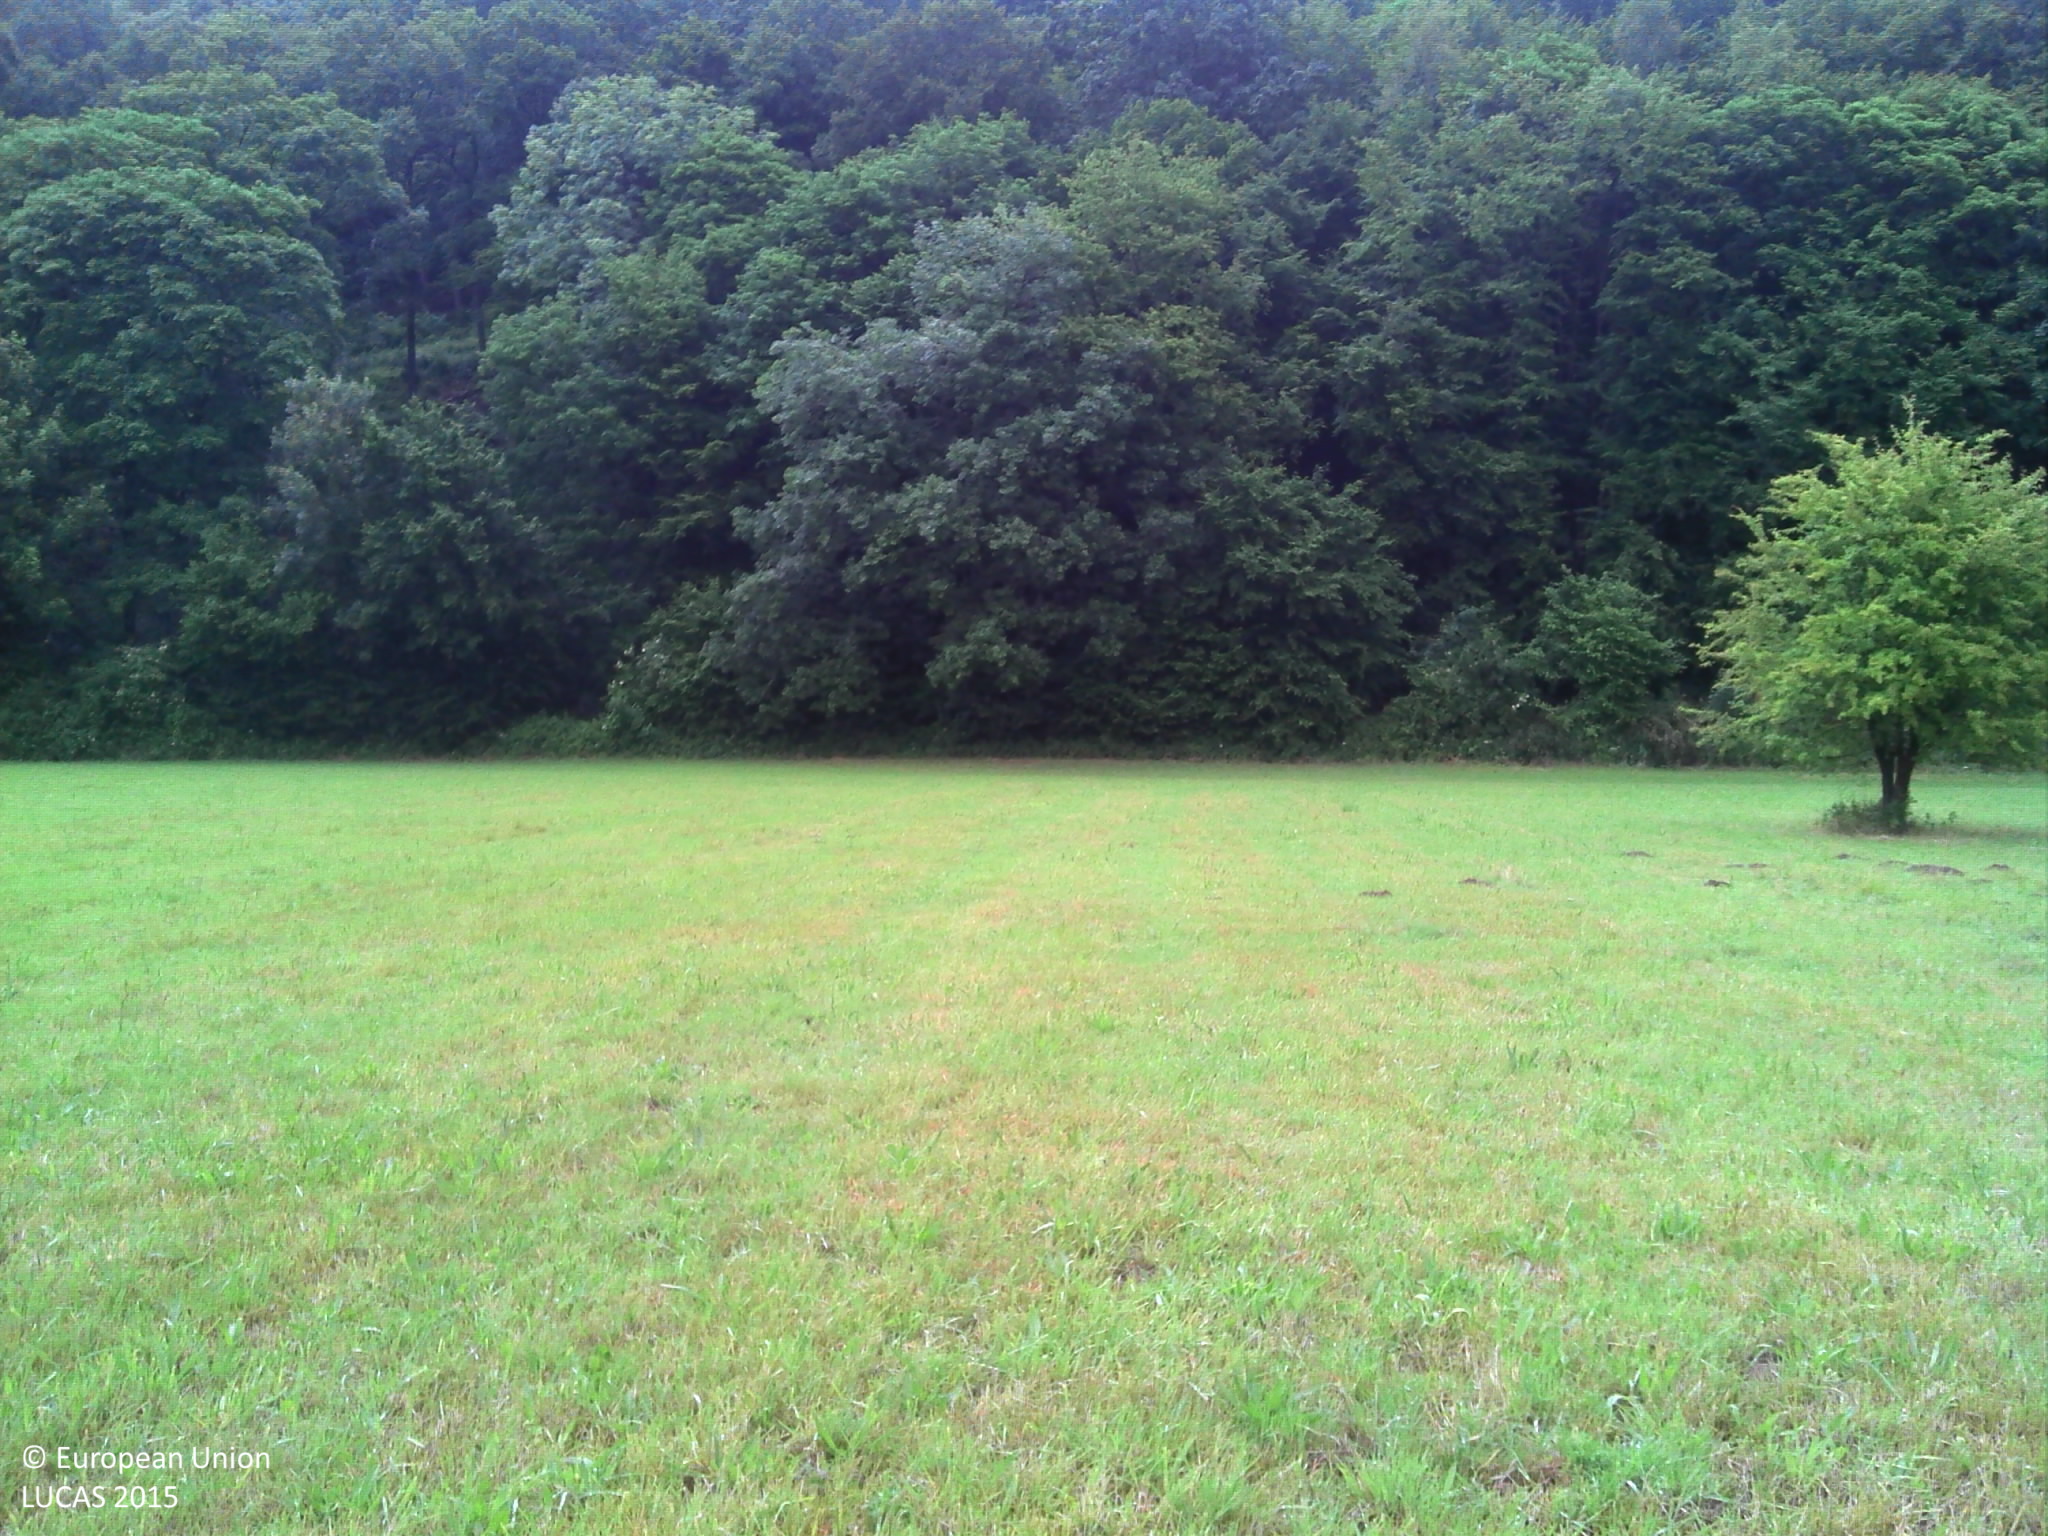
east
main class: Grassland
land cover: Grassland without tree/shrub cover
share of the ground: > 75 %
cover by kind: herbaceous plants 100 %
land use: Agriculture (excluding fallow land and kitchen gardens)
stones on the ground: < 10 %
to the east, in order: Grassland without tree/shrub cover; Fences; Broadleaved woodland; Tracks; Broadleaved woodland
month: June
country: BE
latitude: 50.2226
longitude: 5.5272
